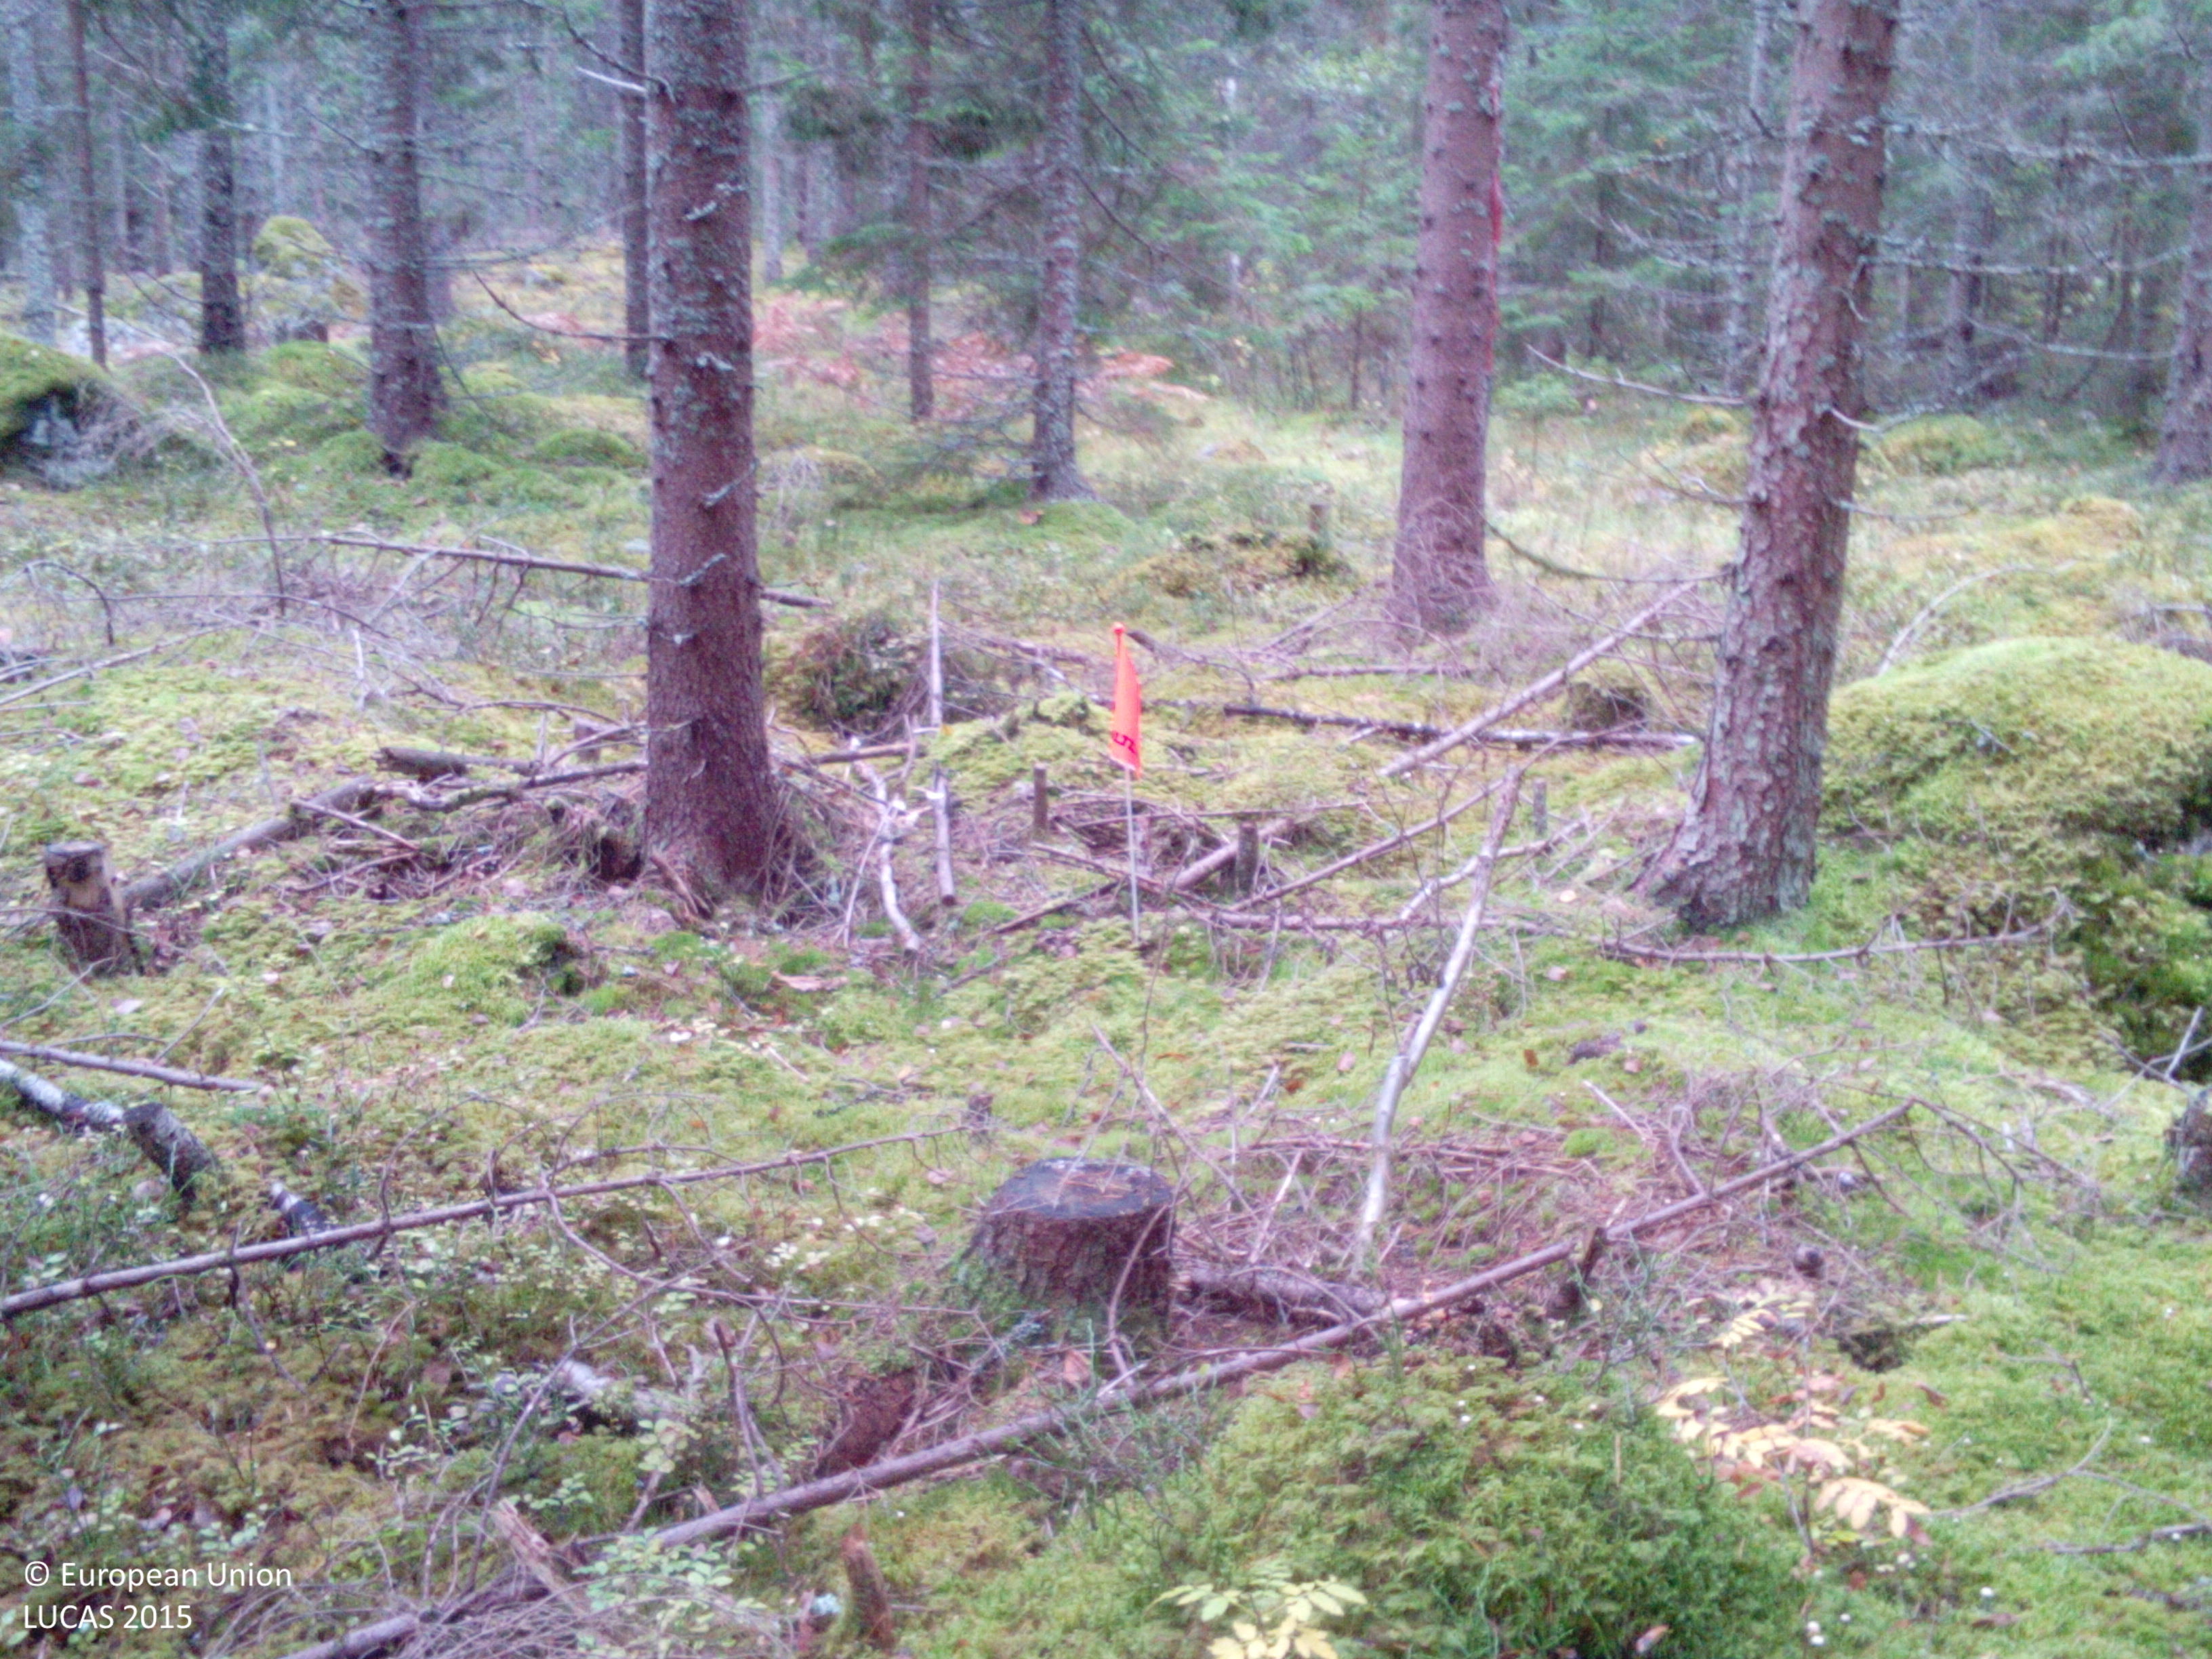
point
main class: Woodland
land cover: Spruce dominated coniferous woodland
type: boreal forest
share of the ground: > 75 %
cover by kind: coniferous forest trees 85 %, lichens and mosses 10 %, herbaceous plants 5 %
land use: Forestry
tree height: > 5 m
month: October
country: SE
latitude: 59.1937
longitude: 16.2427
